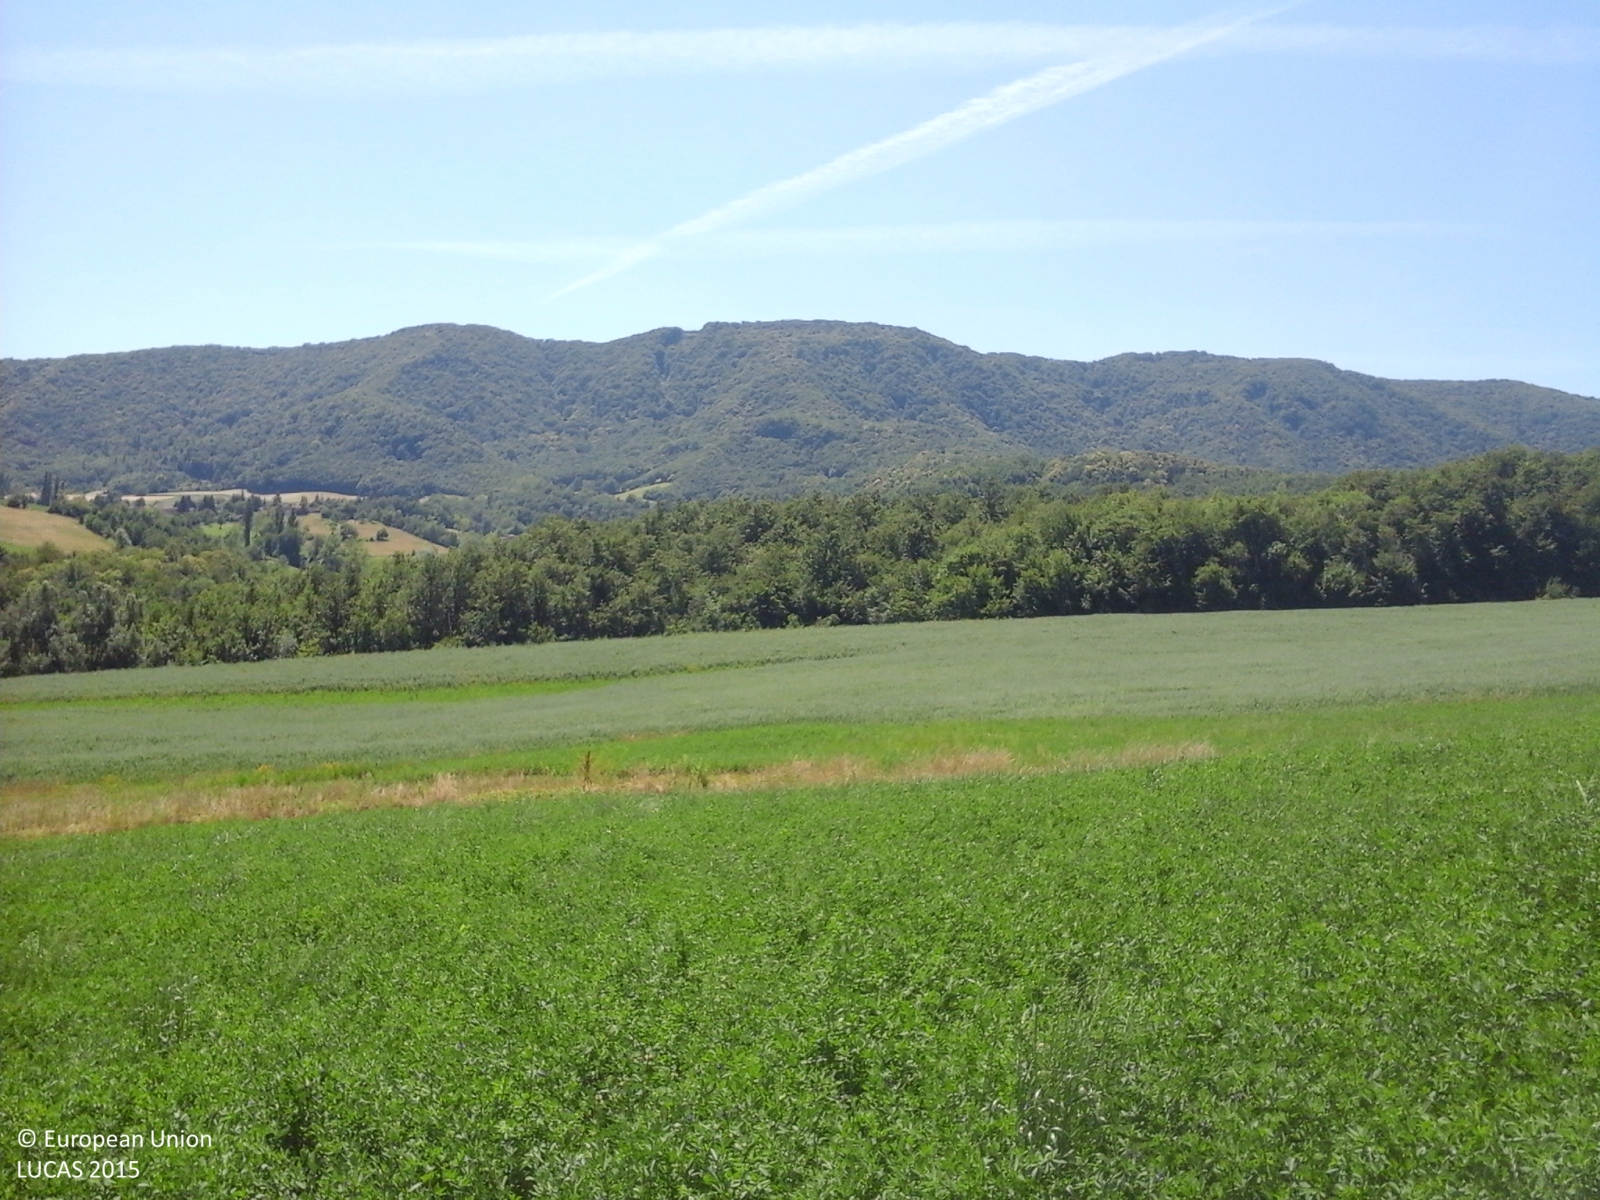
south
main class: Cropland
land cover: Lucerne
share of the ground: > 75 %
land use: Agriculture (excluding fallow land and kitchen gardens)
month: June
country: IT
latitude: 44.5306
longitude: 10.2637
